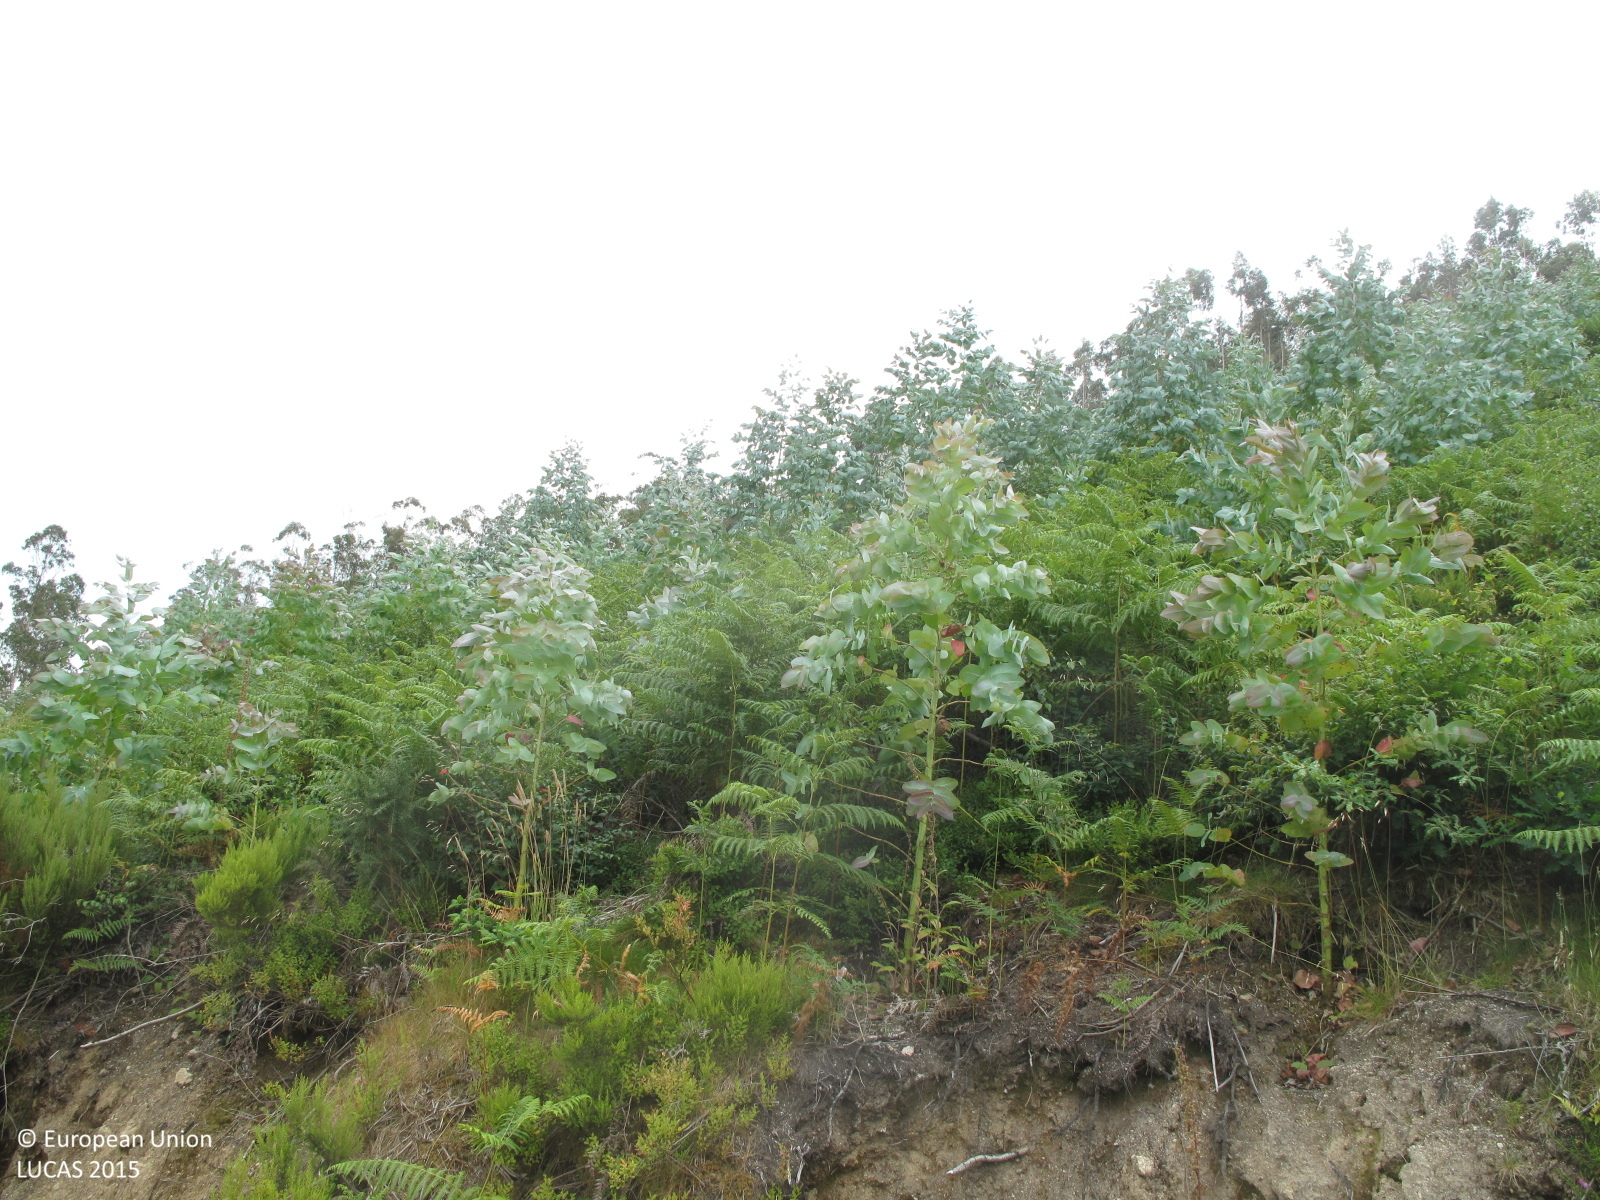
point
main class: Woodland
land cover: Broadleaved woodland
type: exotic forest
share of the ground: 10 - 25 %
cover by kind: herbaceous plants 70 %, broadleaved forest trees 20 %, shrubs 10 %
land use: Forestry
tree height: < 5 m
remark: Clear cut
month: July
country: ES
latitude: 43.4824
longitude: -7.9860
